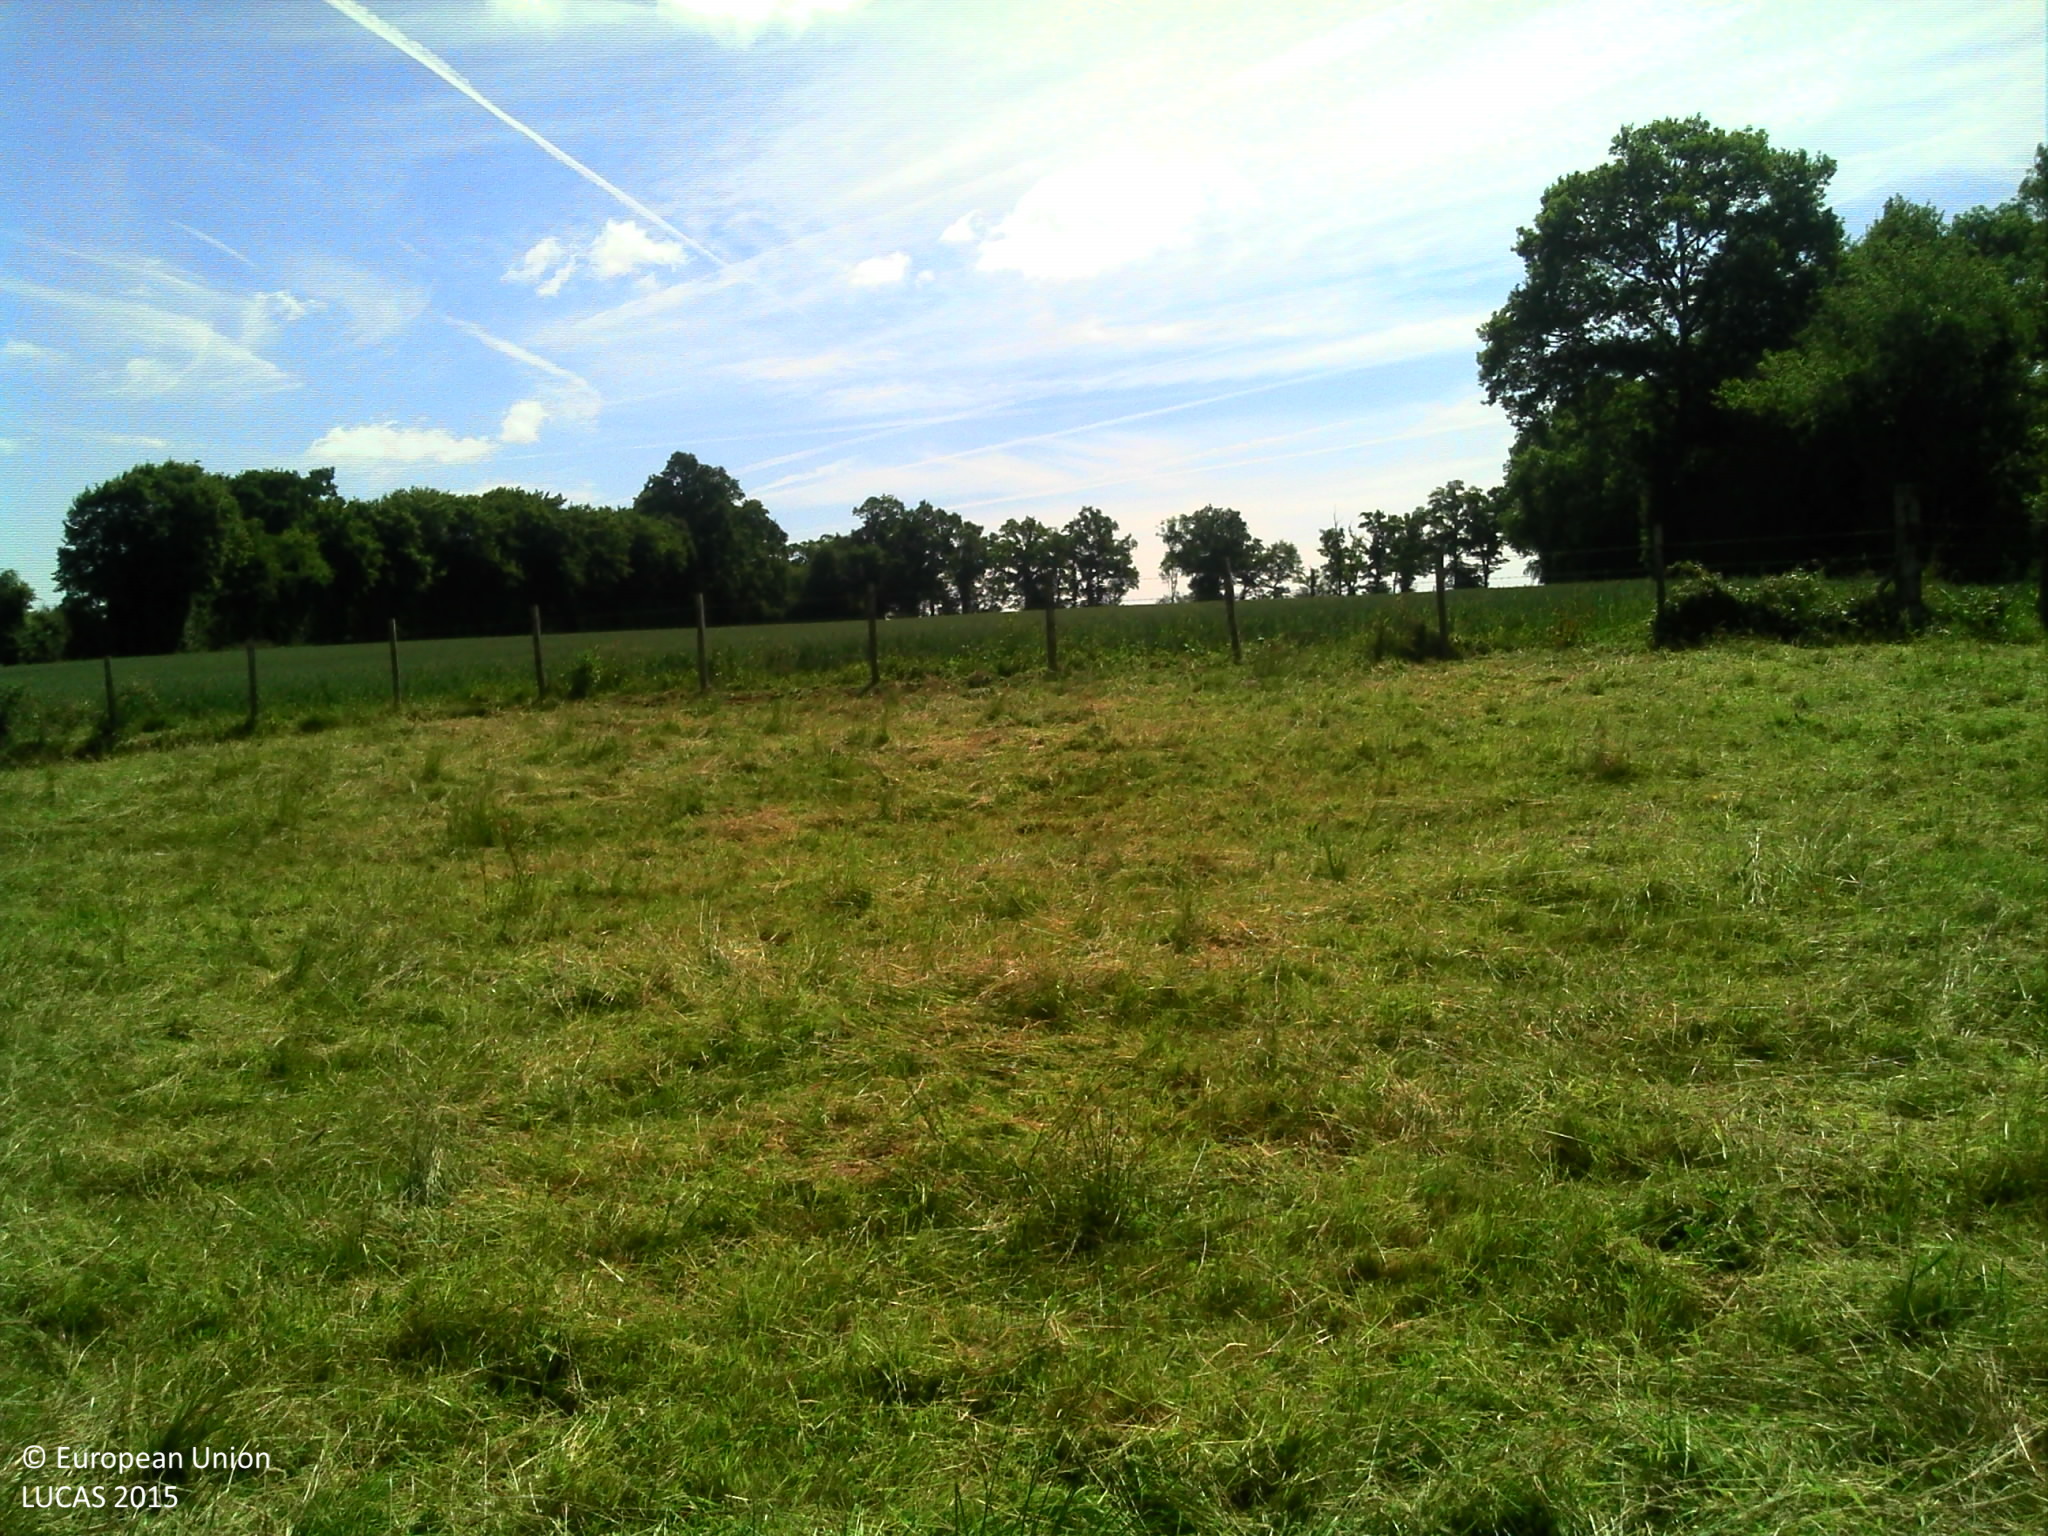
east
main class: Grassland
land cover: Grassland without tree/shrub cover
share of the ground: > 75 %
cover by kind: herbaceous plants 100 %
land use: Agriculture (excluding fallow land and kitchen gardens)
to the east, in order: Grassland without tree/shrub cover; Fences; Grass margins; Durum wheat; Grass margins; Broadleaved woodland; Fences; Grassland without tree/shrub cover
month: June
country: FR
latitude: 48.6277
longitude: -0.1119
